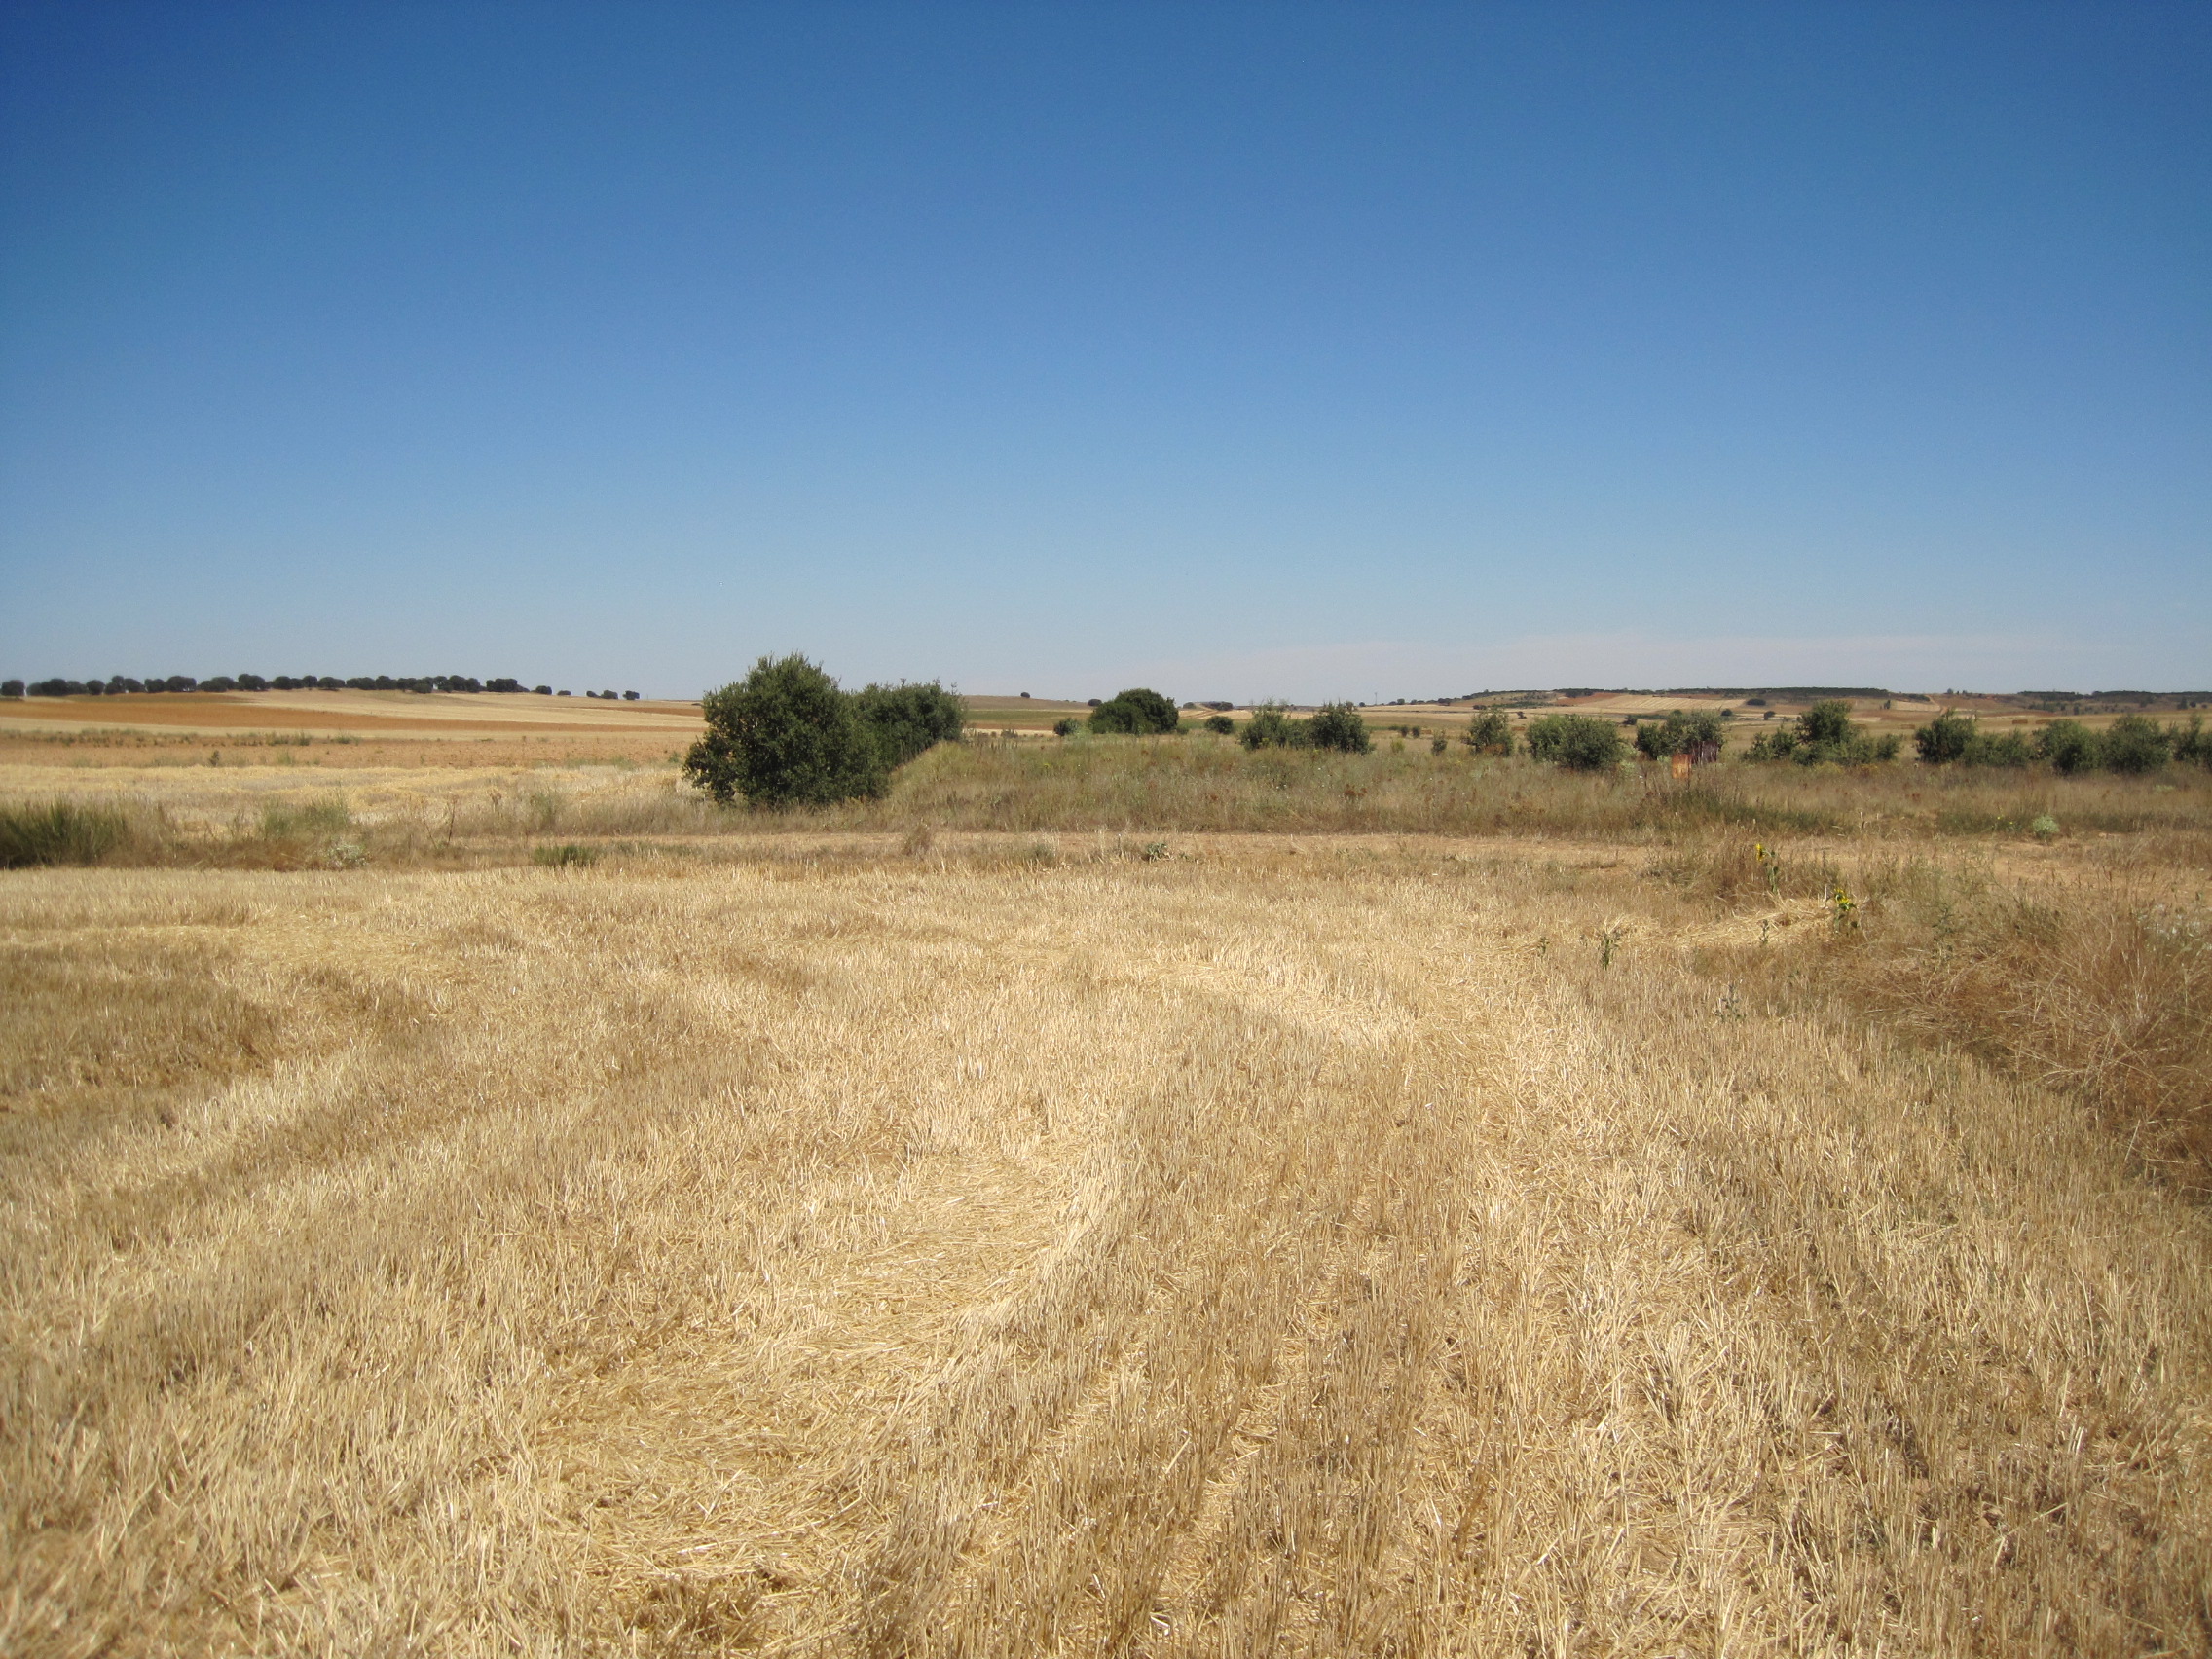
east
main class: Cropland
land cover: Barley
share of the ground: < 10 %
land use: Agriculture (excluding fallow land and kitchen gardens)
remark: Harvested field
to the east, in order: Barley; Grass margins; Tracks; Grass margins; Rivers and streams; Shrubland without tree cover; Oats; Grass margins; Single bushes/trees; Rivers and streams; Grass margins; Oats
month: July
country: ES
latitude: 42.1423
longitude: -5.6658
